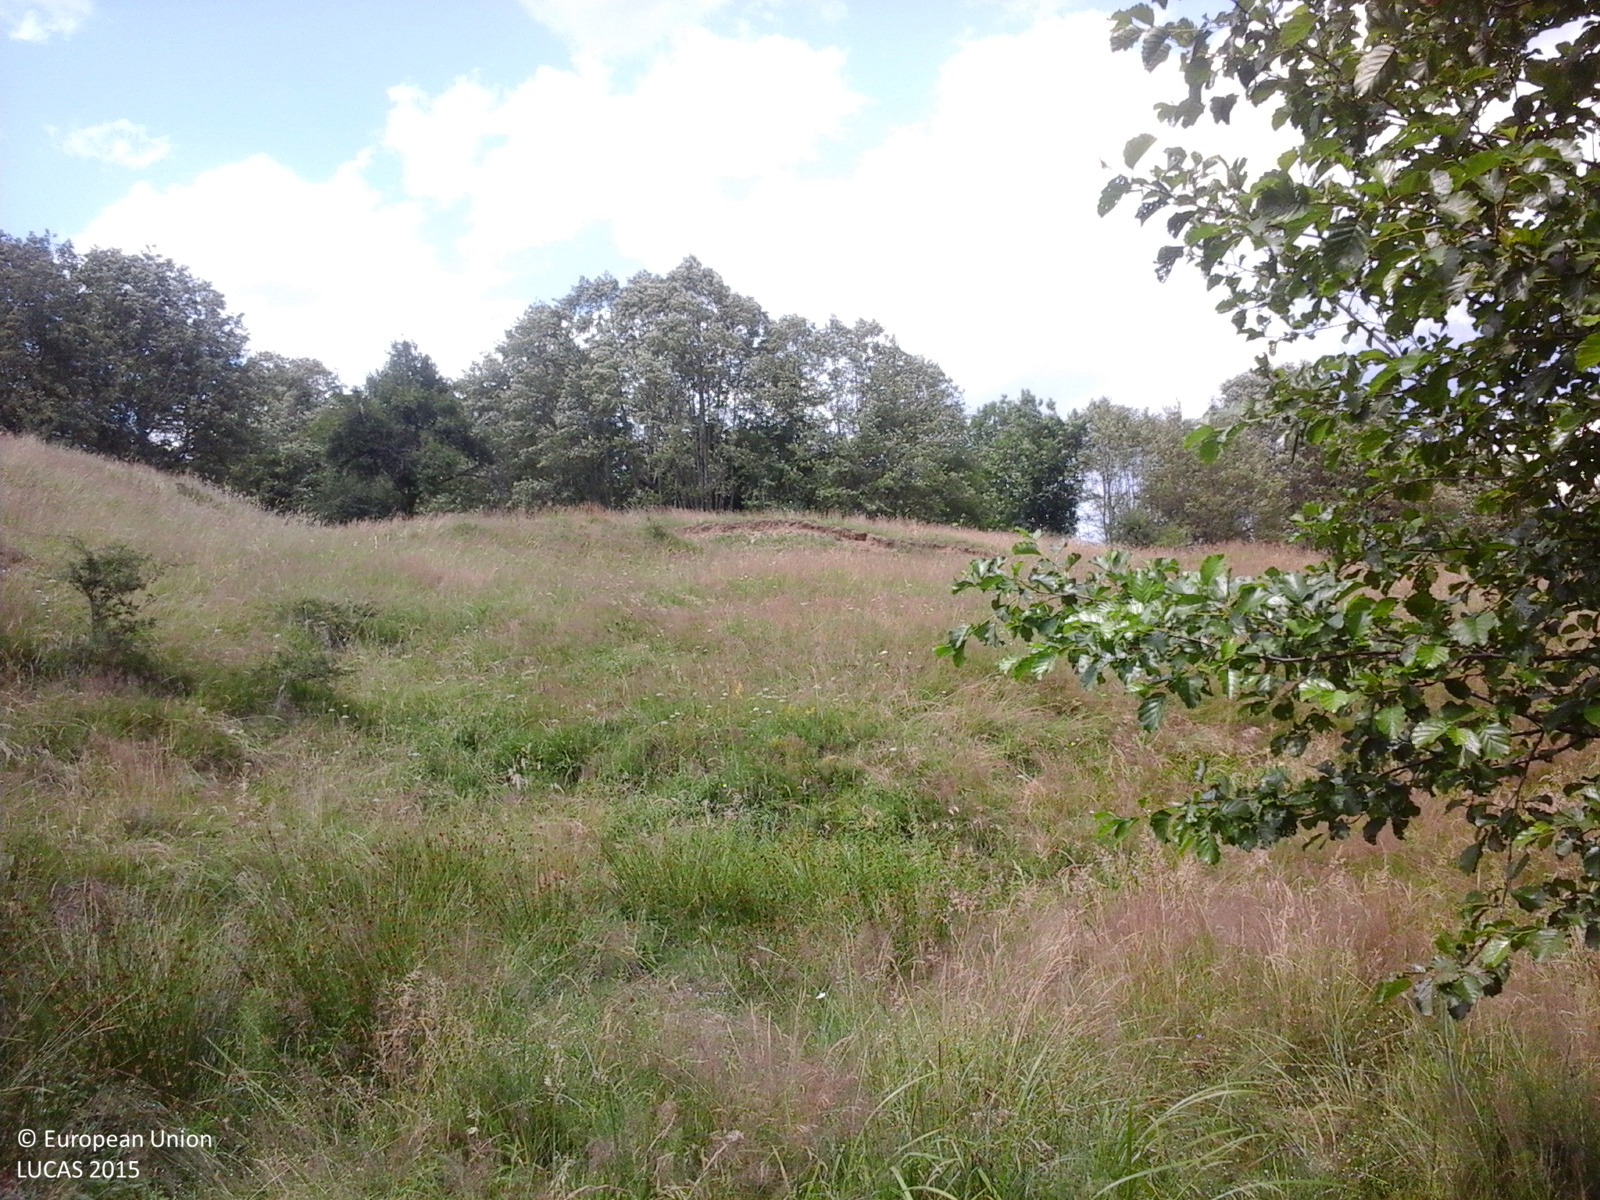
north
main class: Grassland
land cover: Grassland with sparse tree/shrub cover
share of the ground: > 75 %
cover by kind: herbaceous plants 95 %, broadleaved forest trees 5 %
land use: Agriculture (excluding fallow land and kitchen gardens)
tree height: > 5 m
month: July
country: RO
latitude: 45.3722
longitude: 24.7810
